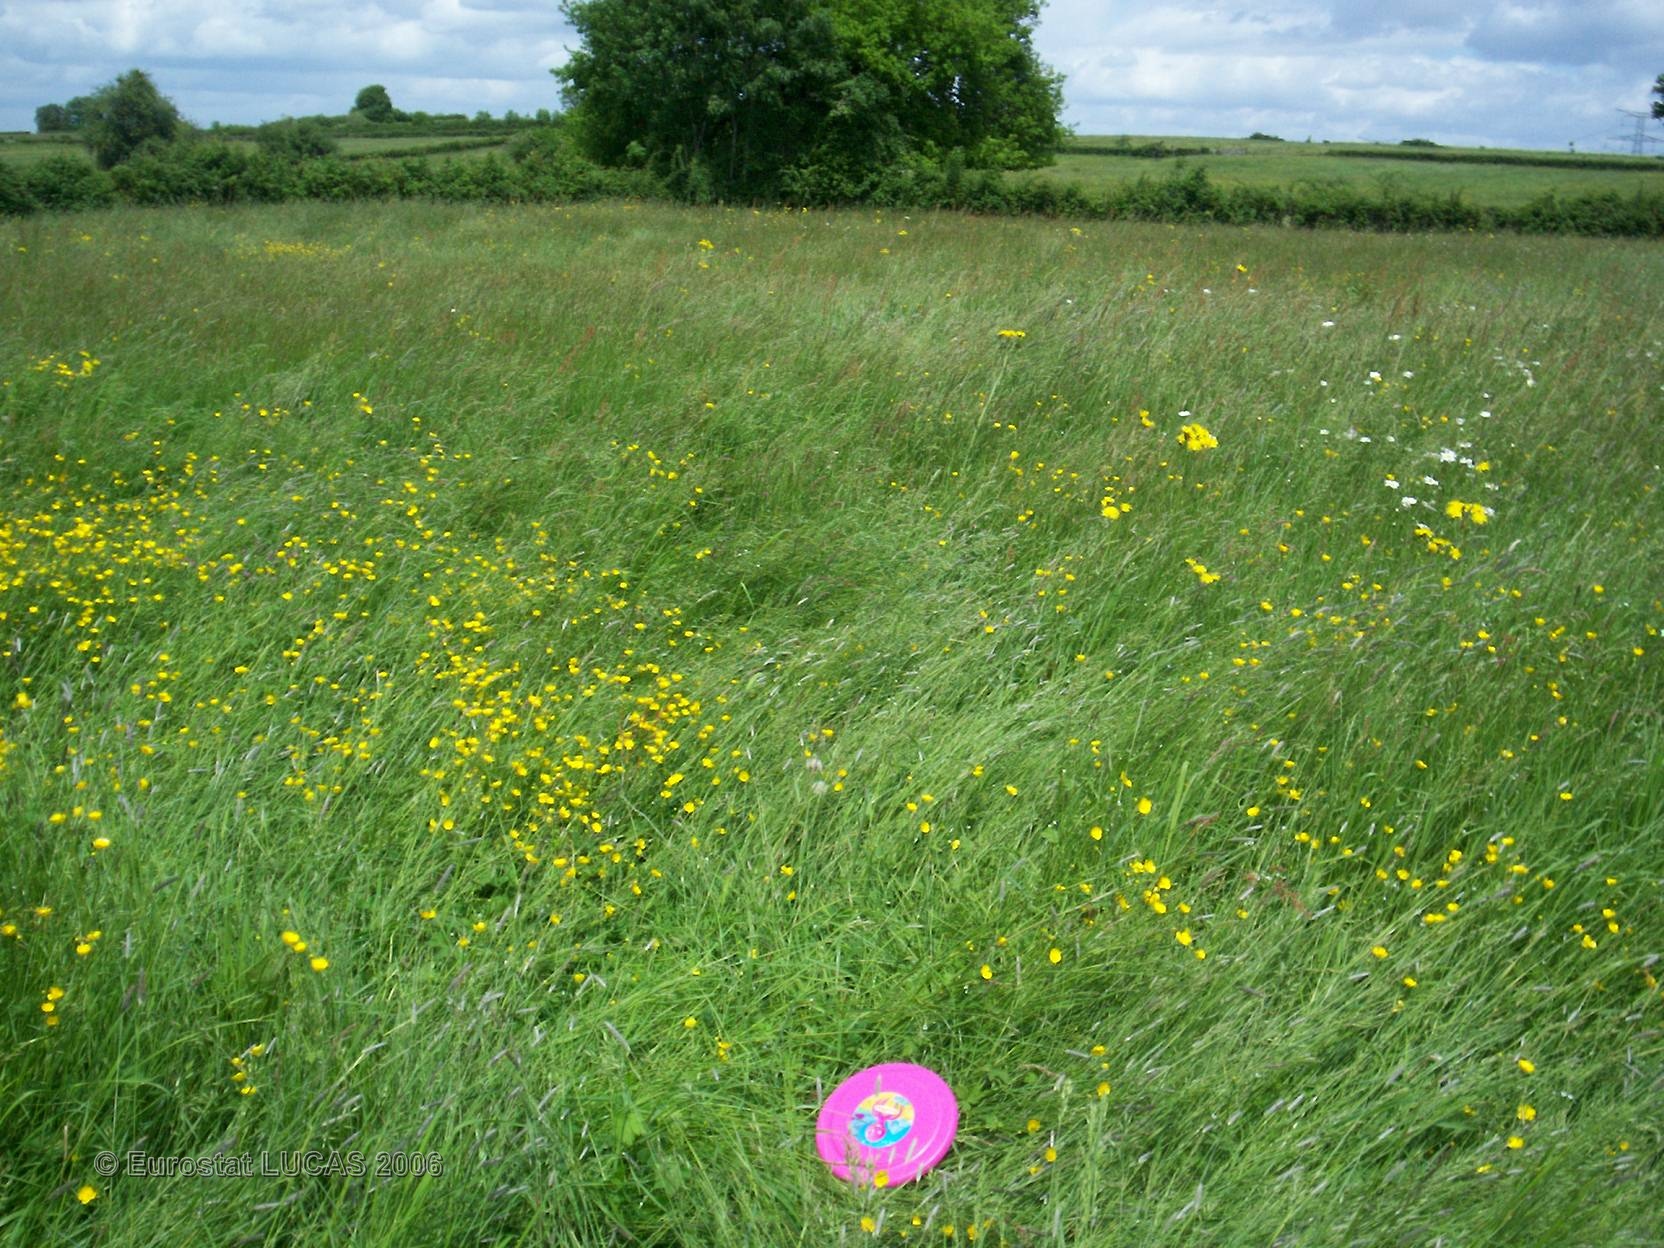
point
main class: Grassland
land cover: Grassland without tree/shrub cover
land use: Agriculture (excluding fallow land and kitchen gardens)
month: May
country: FR
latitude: 47.0638
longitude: 4.6150
